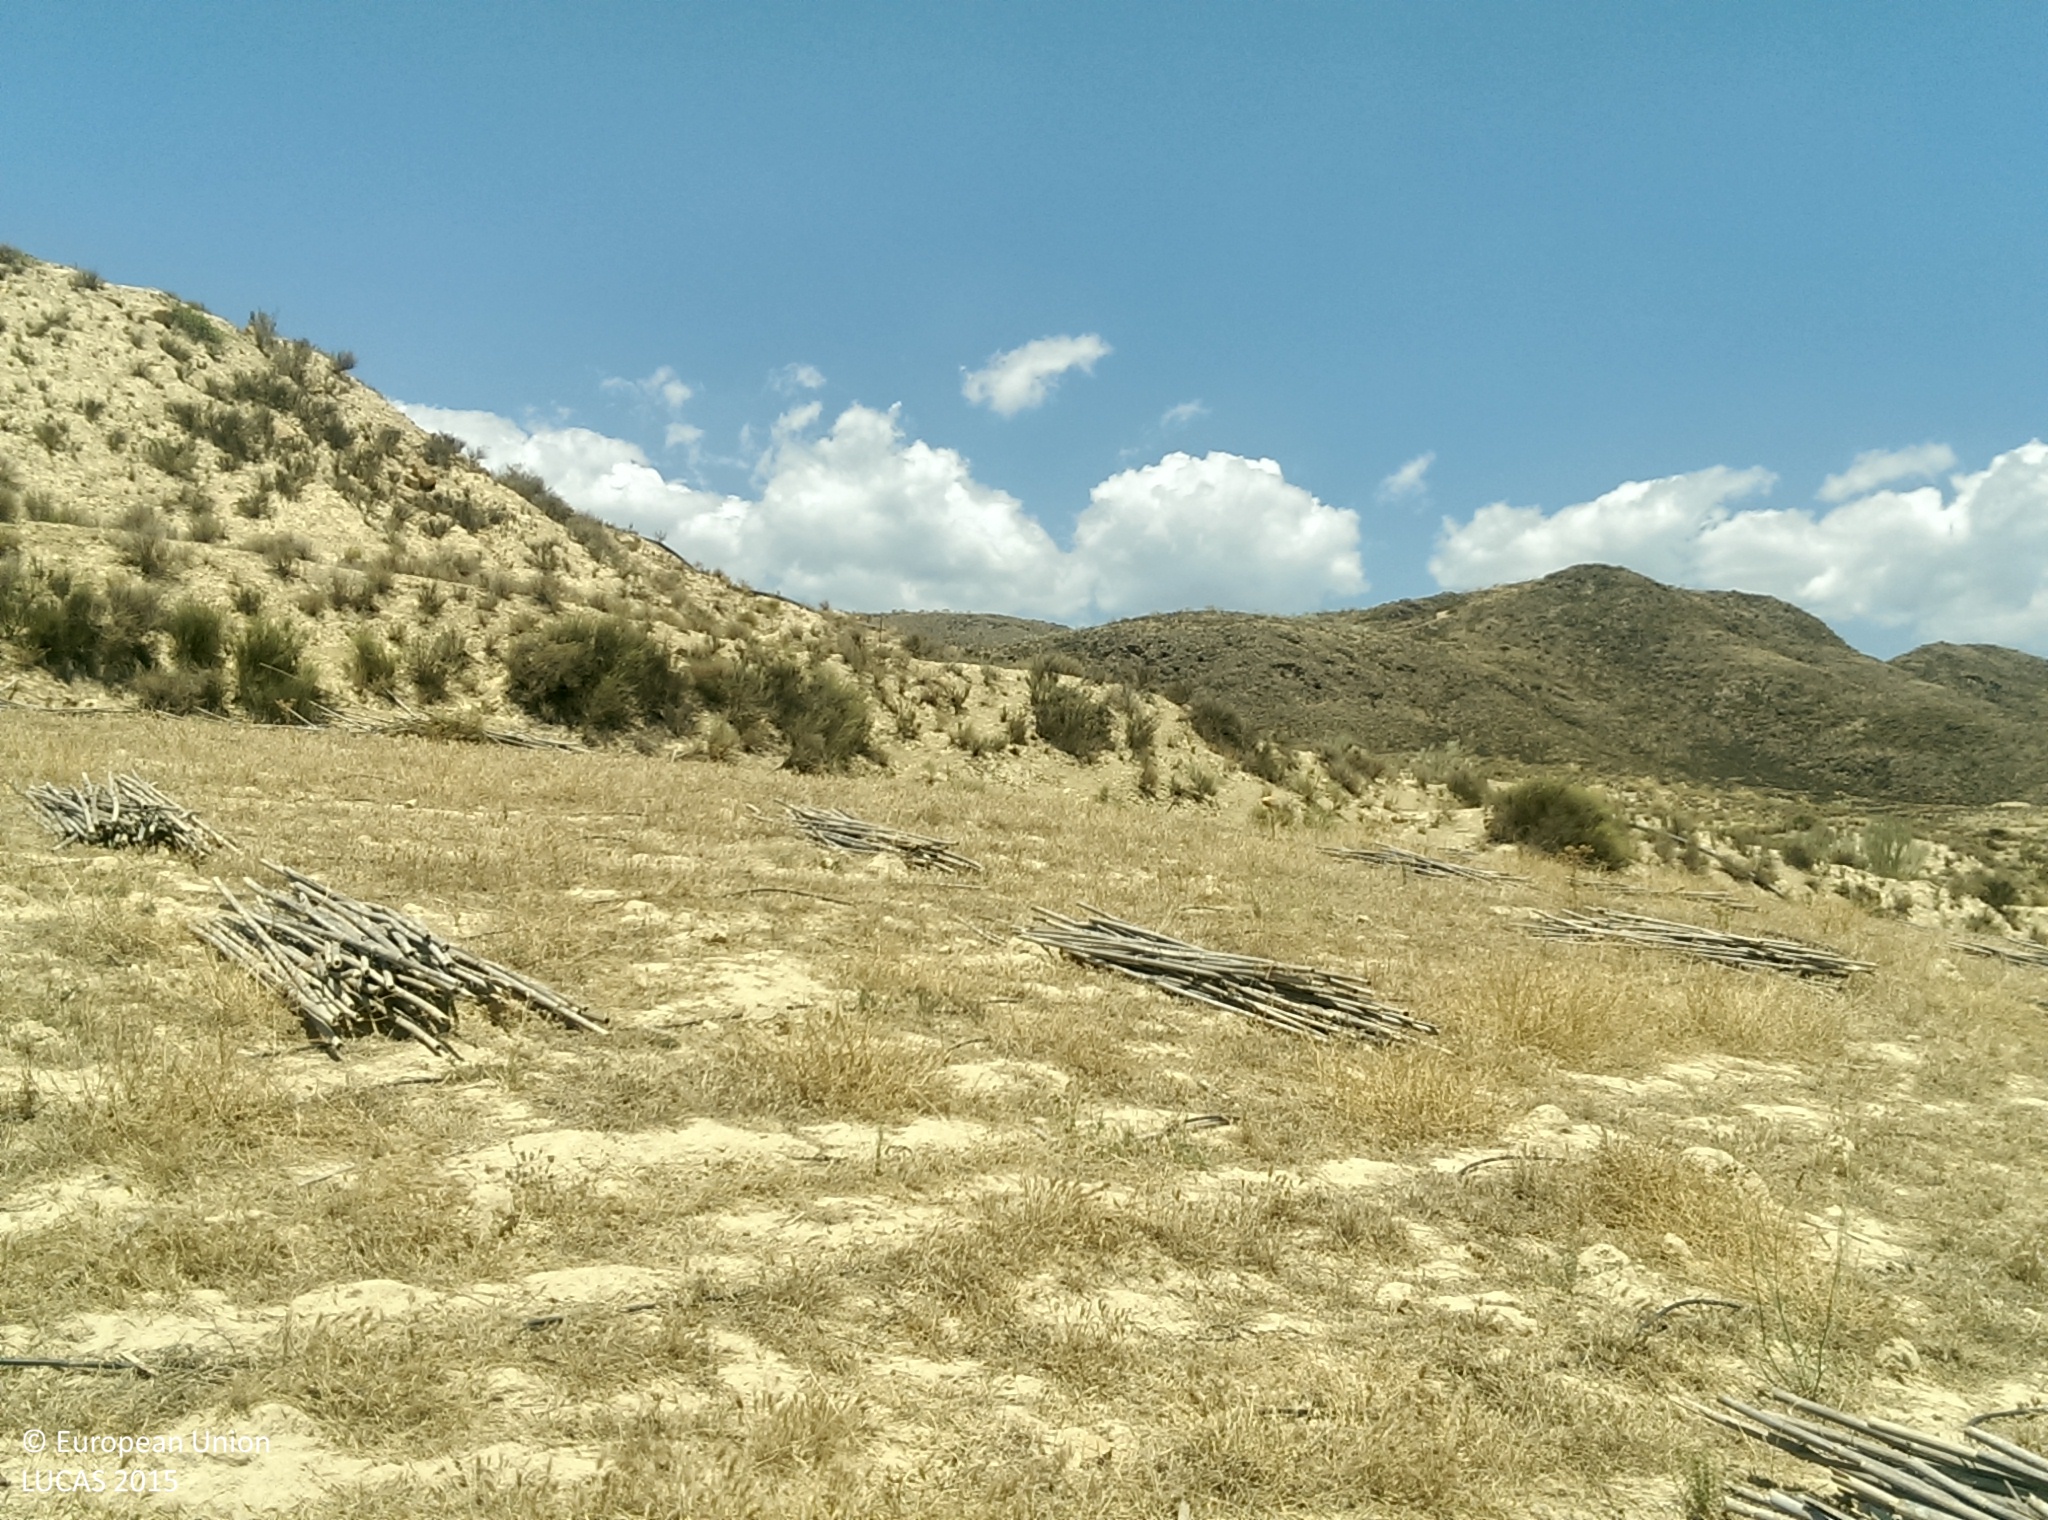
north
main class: Grassland
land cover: Spontaneously vegetated surfaces
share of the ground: 50 - 75 %
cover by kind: herbaceous plants 70 %, unconsolidated bare surface 30 %
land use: Fallow land
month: July
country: ES
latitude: 36.9374
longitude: -3.0386
